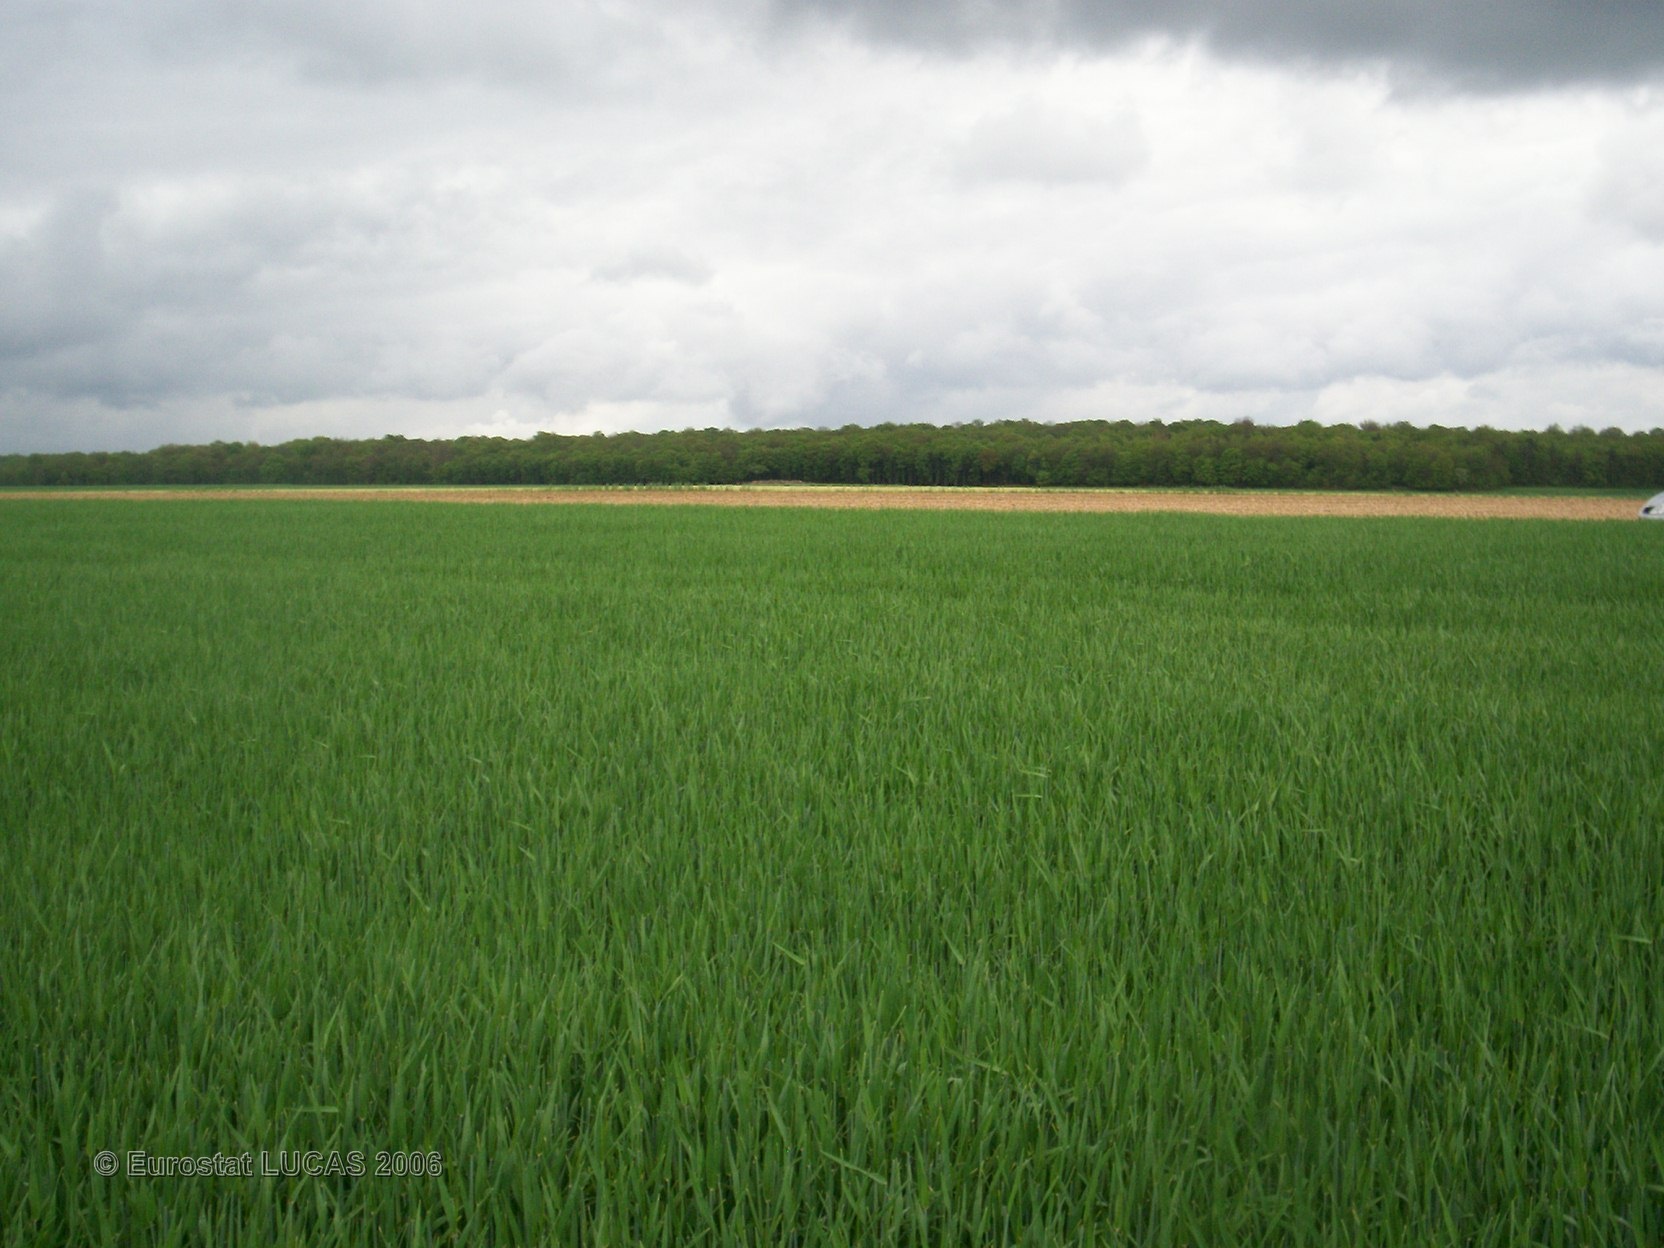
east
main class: Cropland
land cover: Barley
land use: Agriculture (excluding fallow land and kitchen gardens)
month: May
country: FR
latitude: 47.7677
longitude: 4.6216
